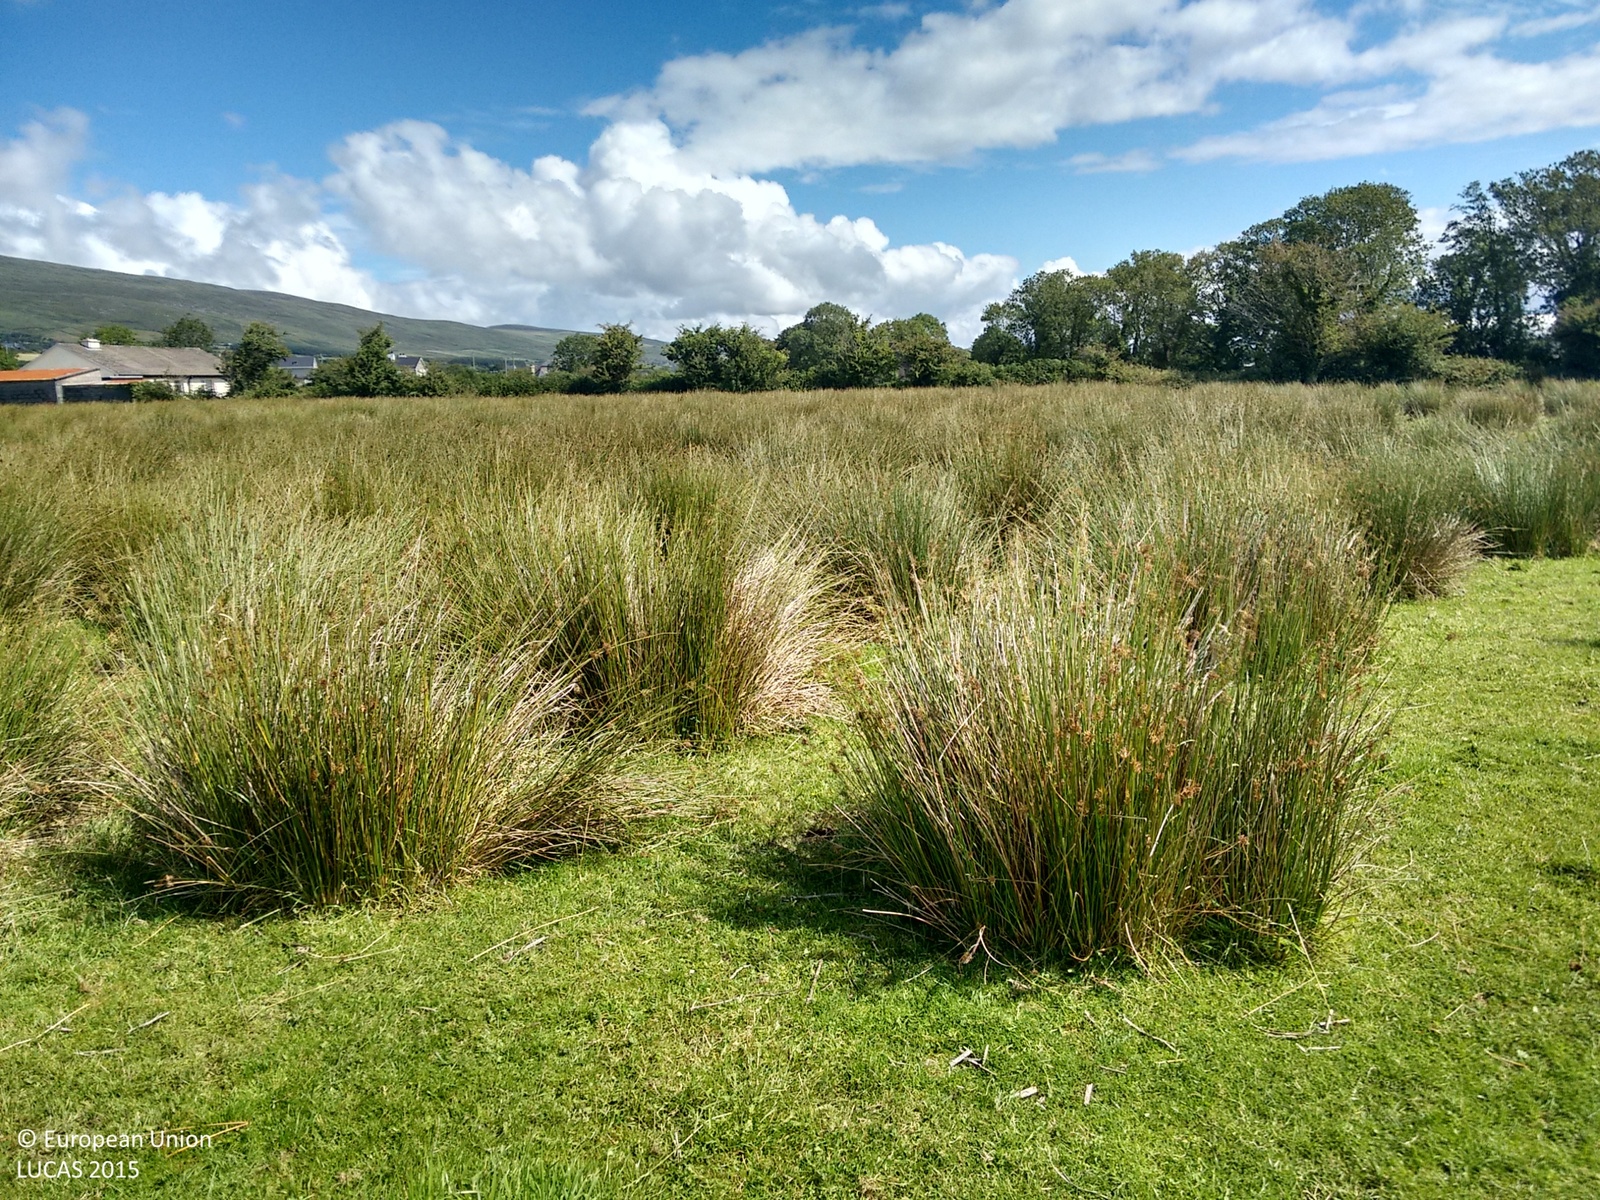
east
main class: Grassland
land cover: Grassland without tree/shrub cover
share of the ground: > 75 %
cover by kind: herbaceous plants 100 %
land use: Agriculture (excluding fallow land and kitchen gardens)
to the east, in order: Grassland without tree/shrub cover; Fences; Abandoned hedges; Ditches and canals; Fences; Grassland without tree/shrub cover; Fences; Lines of trees; Artificial constructions in urban areas; Grassland without tree/shrub cover; Electric lines; Grassland without tree/shrub cover; Abandoned hedges
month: August
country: IE
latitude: 52.1740
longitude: -9.7654
